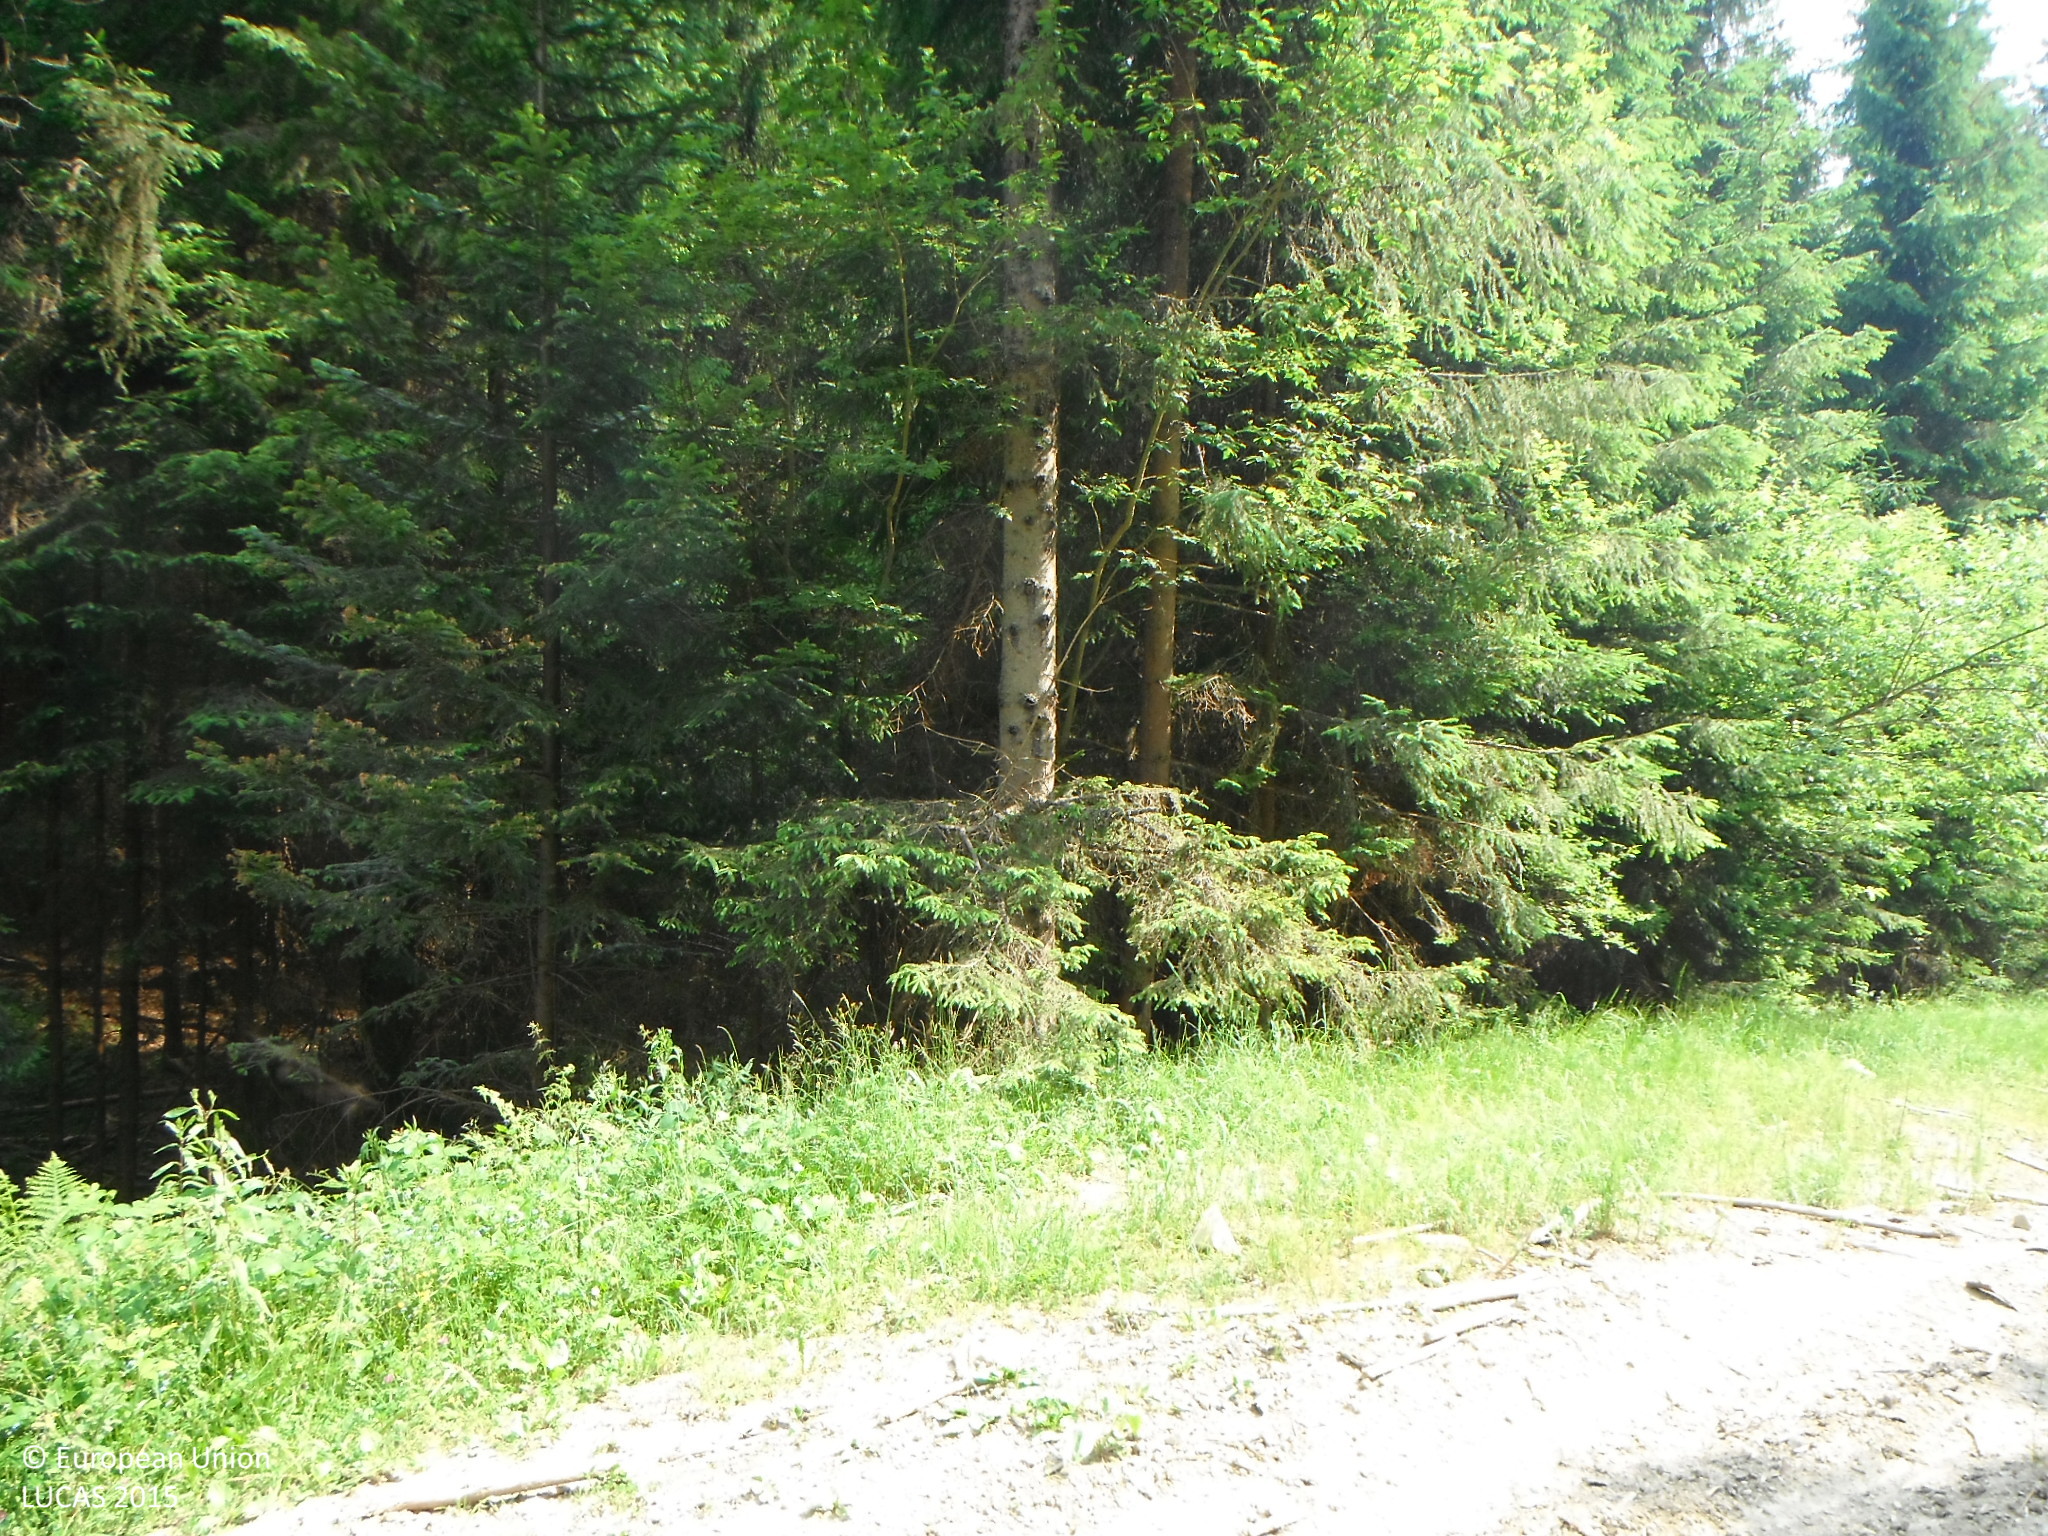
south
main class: Woodland
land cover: Spruce dominated coniferous woodland
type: alpine coniferous forest
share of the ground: > 75 %
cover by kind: coniferous forest trees 80 %, shrubs 10 %, herbaceous plants 10 %
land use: Forestry
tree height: > 5 m
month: July
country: SK
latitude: 49.4782
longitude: 19.5086
